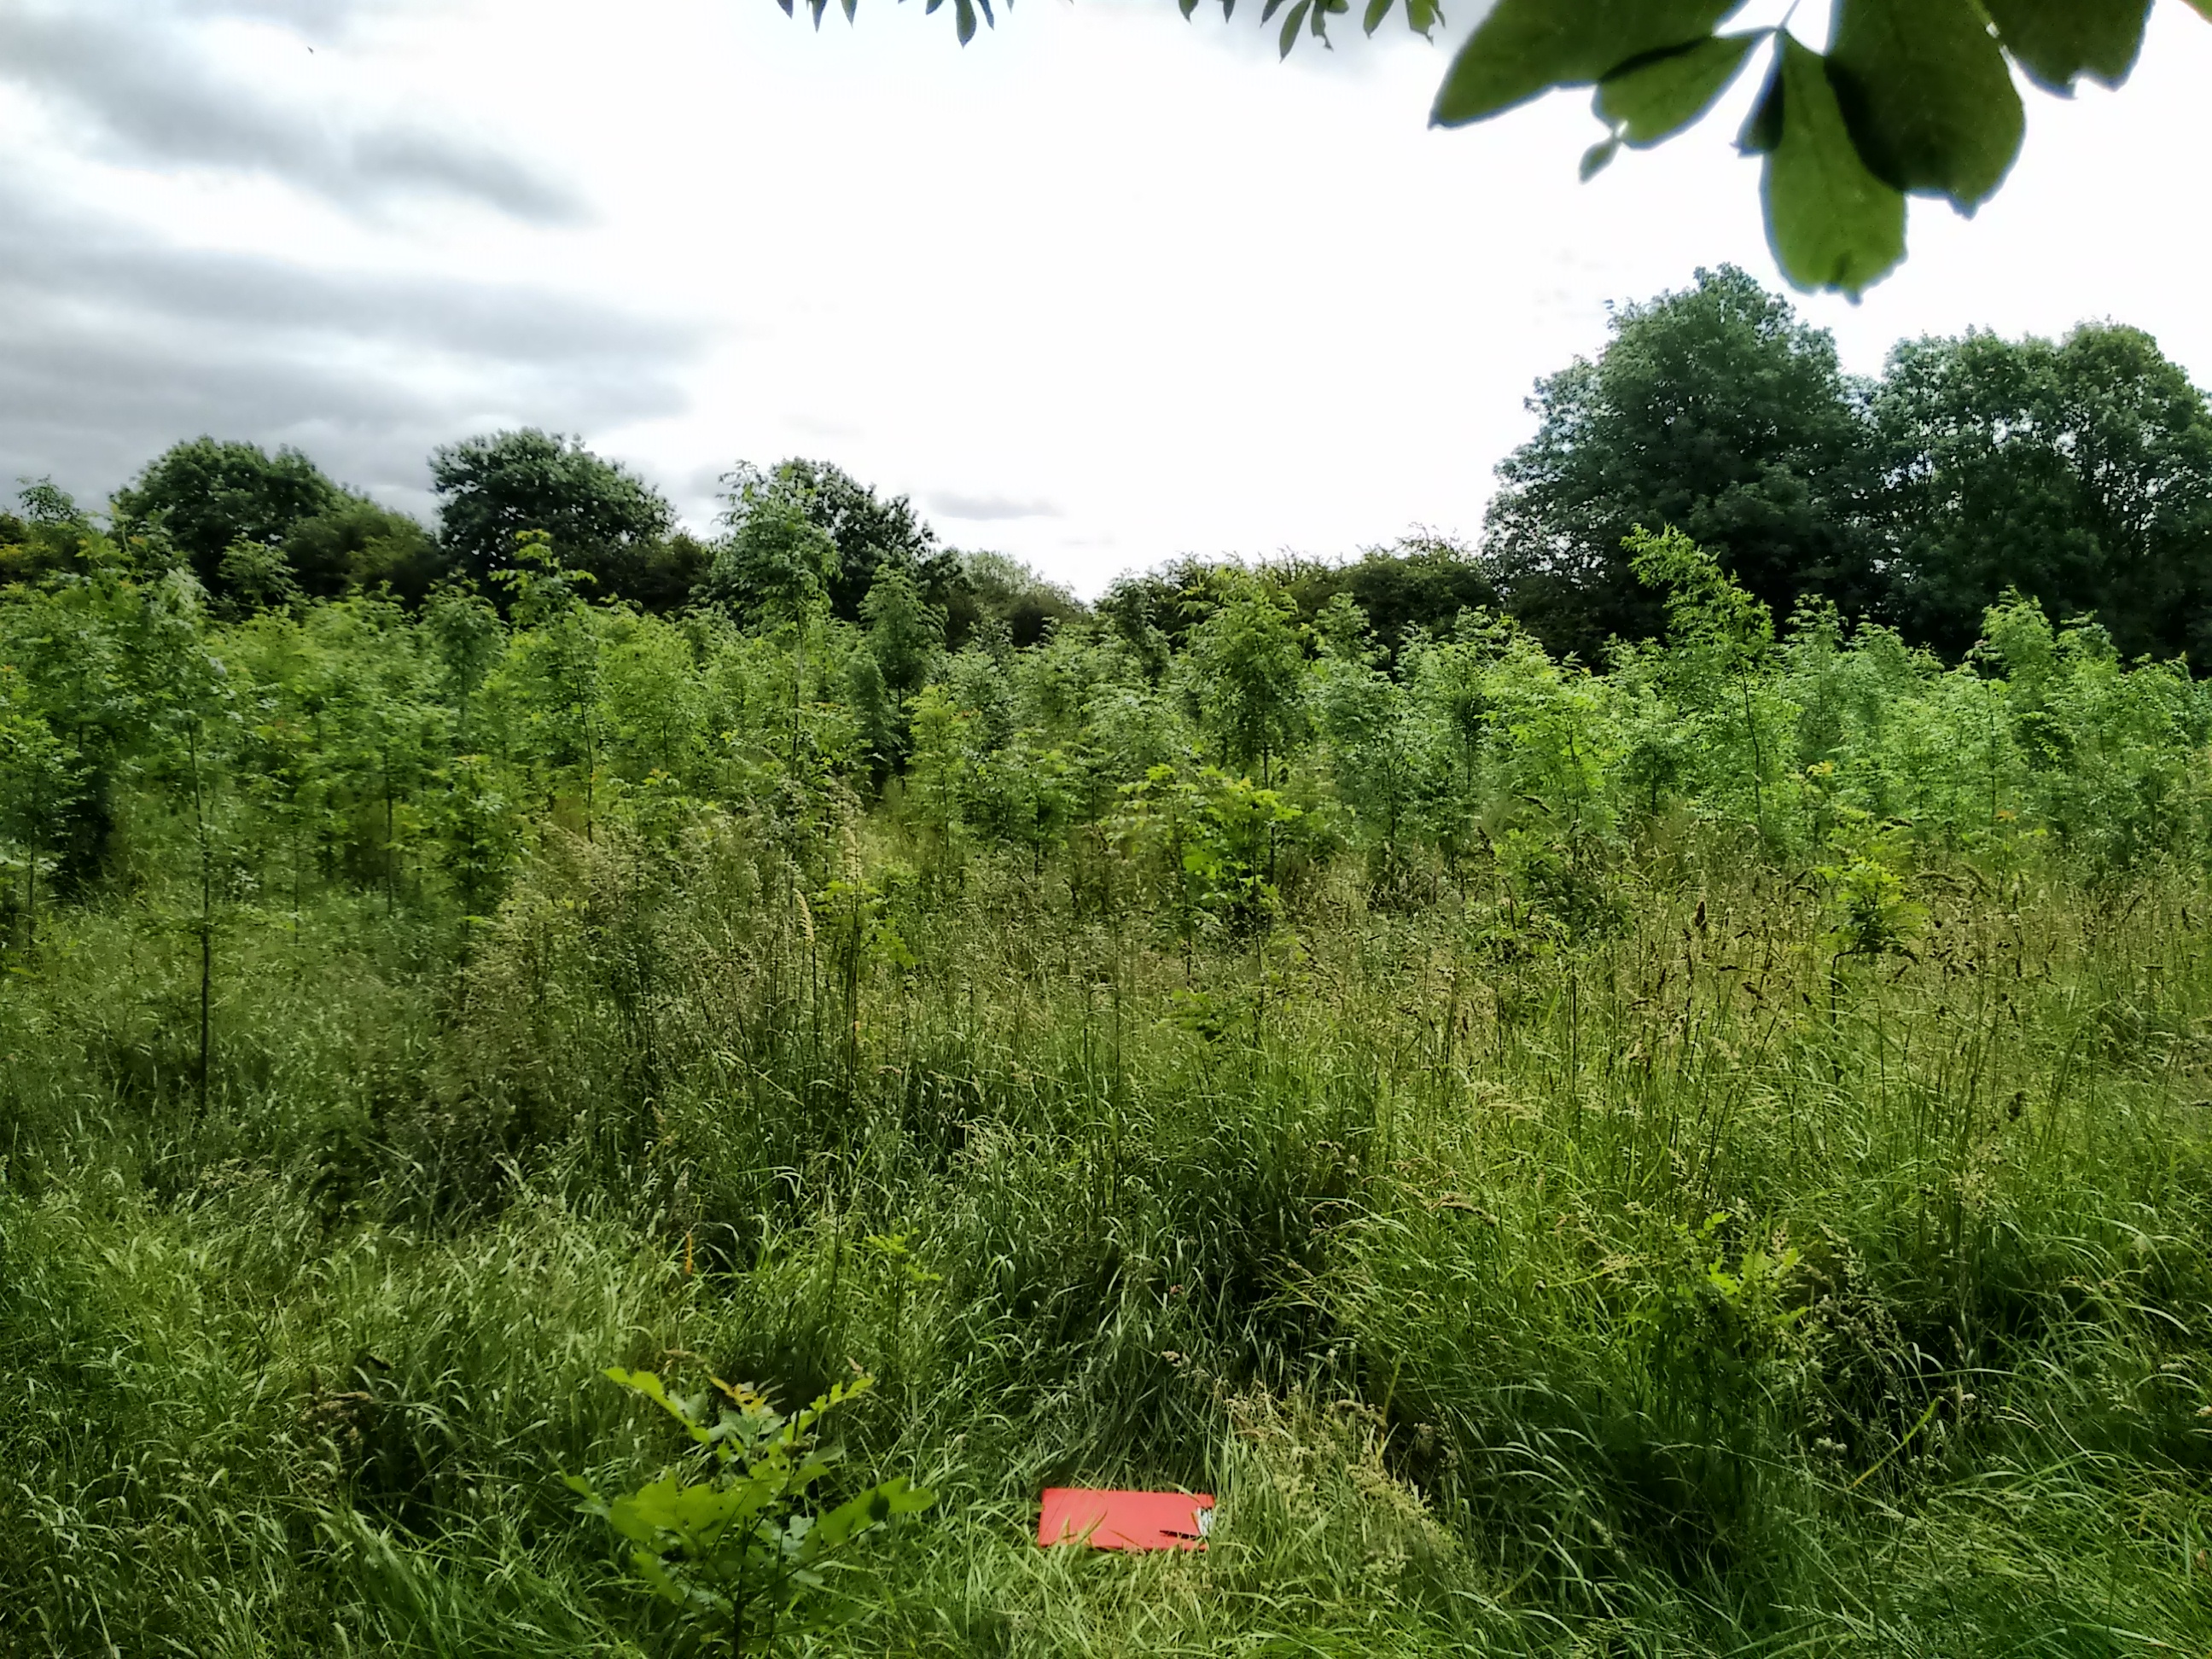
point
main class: Woodland
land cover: Broadleaved woodland
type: acidophilous oak and oak-birch forest
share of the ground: 50 - 75 %
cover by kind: broadleaved forest trees 70 %, herbaceous plants 30 %
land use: Forestry
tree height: < 5 m
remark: Nursery
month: June
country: IE
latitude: 53.3245
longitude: -7.7785
